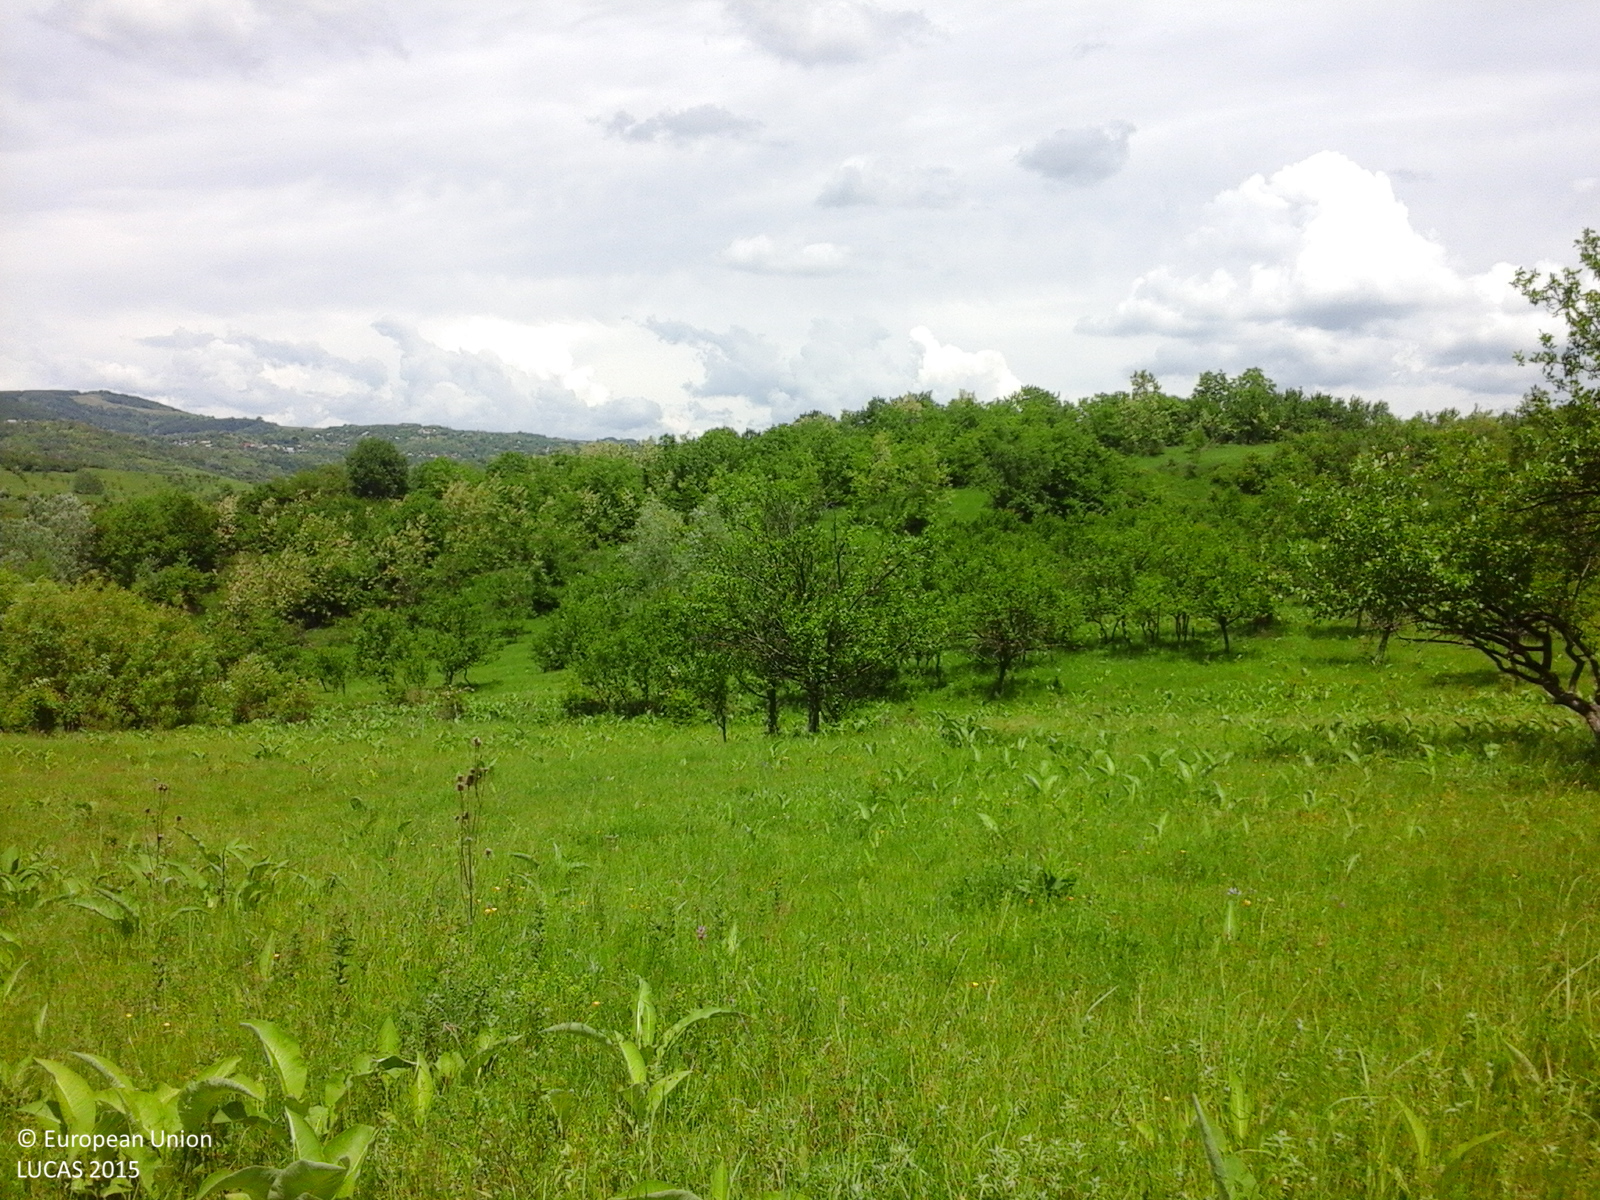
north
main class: Grassland
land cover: Grassland without tree/shrub cover
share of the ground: > 75 %
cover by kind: herbaceous plants 100 %
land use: Agriculture (excluding fallow land and kitchen gardens)
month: May
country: RO
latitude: 45.1577
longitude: 26.1023
